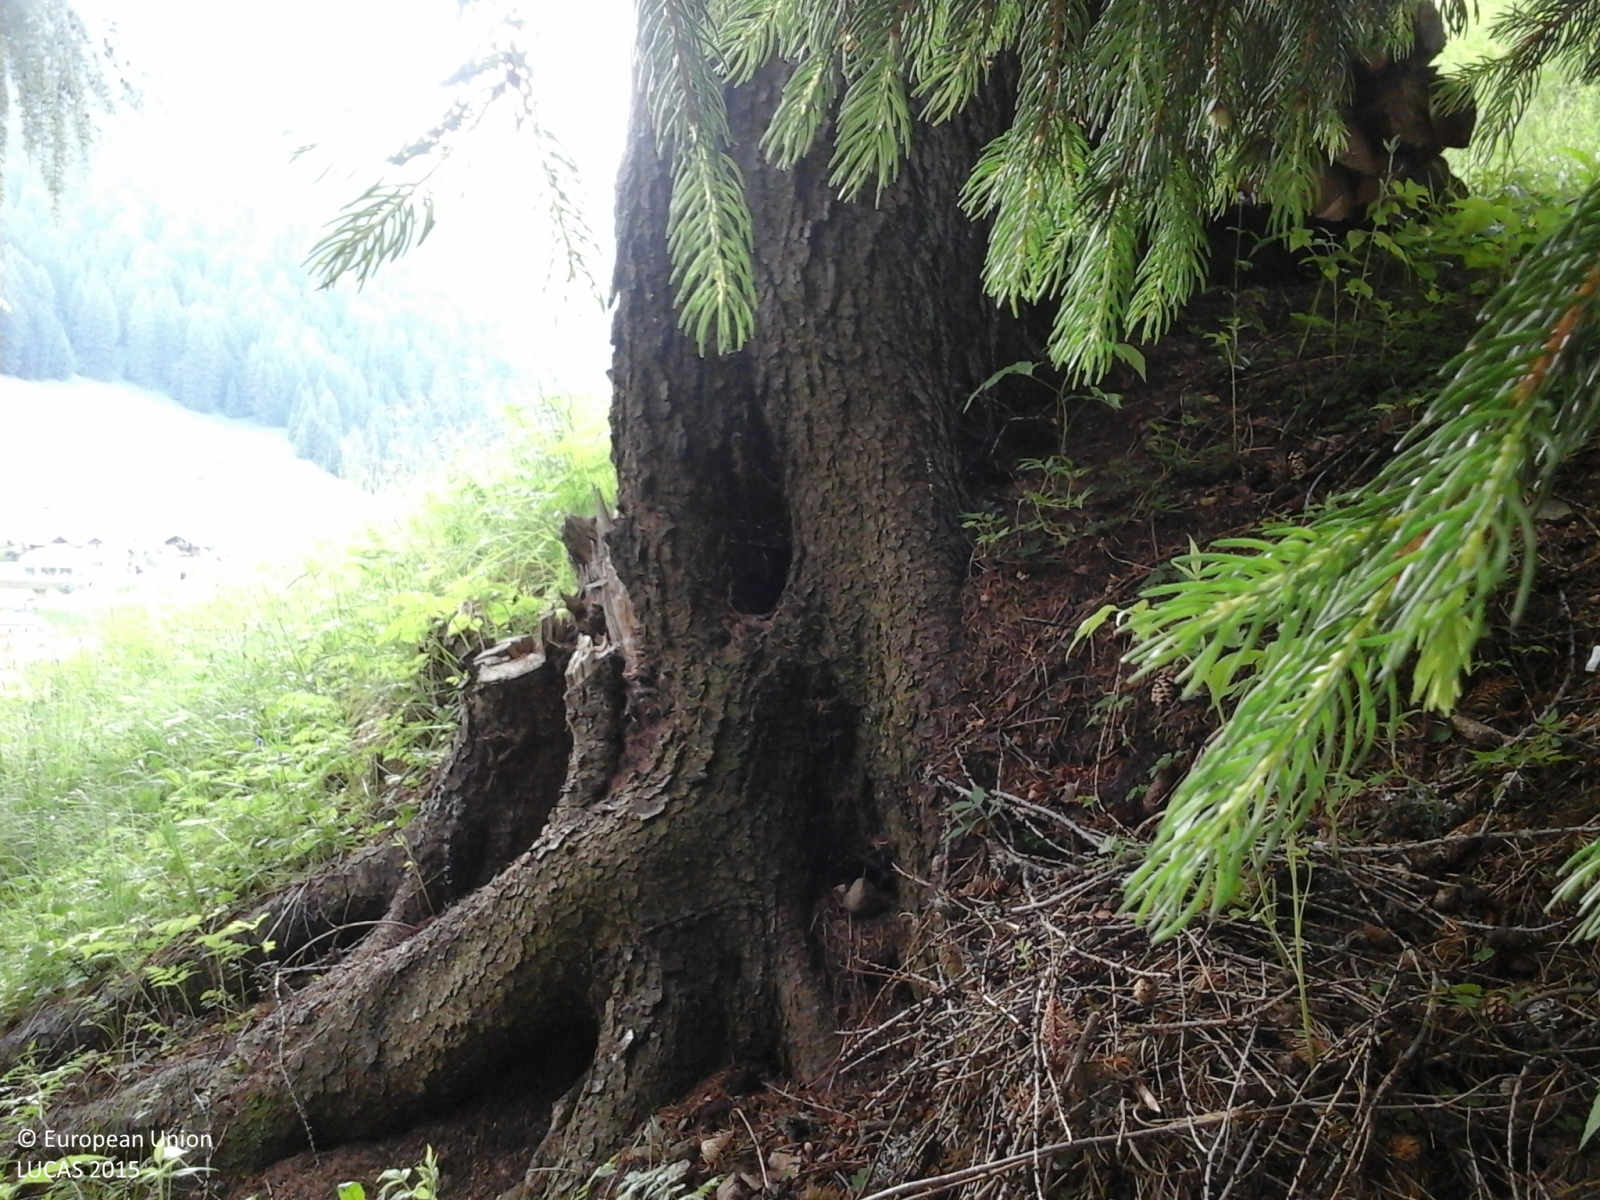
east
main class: Woodland
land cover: Spruce dominated coniferous woodland
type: alpine coniferous forest
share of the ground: > 75 %
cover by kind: coniferous forest trees 100 %
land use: Forestry
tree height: > 5 m
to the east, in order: Spruce dominated coniferous woodland; Grassland without tree/shrub cover; Artificial constructions in urban areas; Grassland without tree/shrub cover; Tracks; Grassland without tree/shrub cover; Electric lines; Grassland without tree/shrub cover; Artificial constructions in urban areas
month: June
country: IT
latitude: 46.5529
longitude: 11.7588
